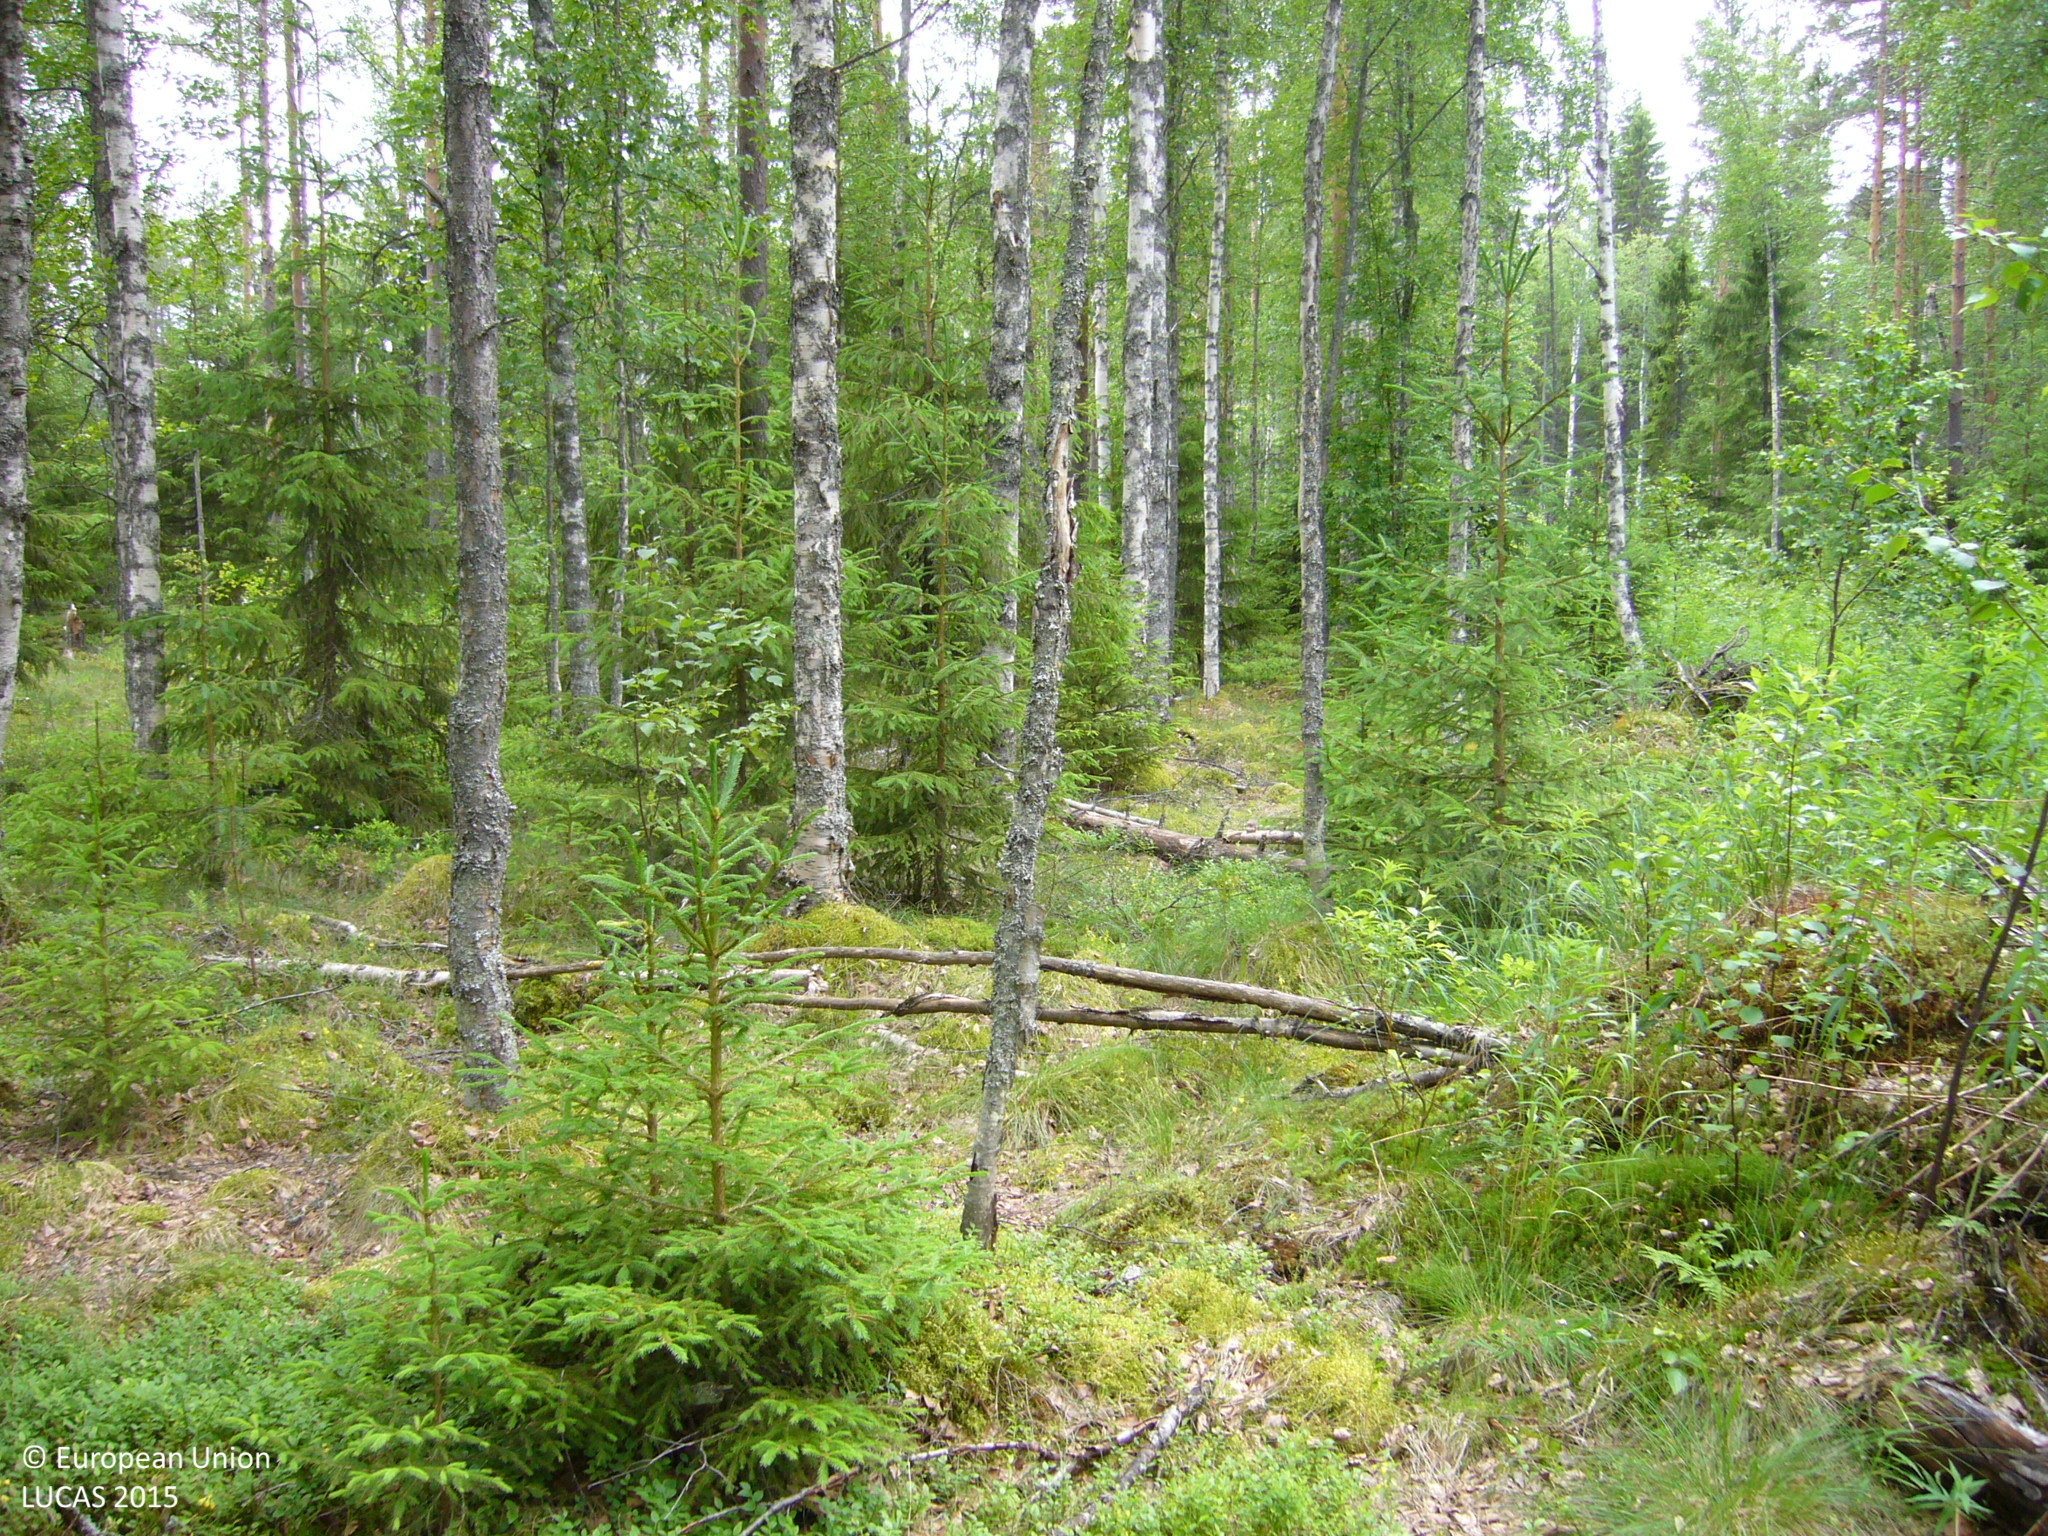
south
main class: Woodland
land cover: Pine dominated mixed woodland
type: boreal forest
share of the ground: 50 - 75 %
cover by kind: broadleaved forest trees 40 %, shrubs 35 %, coniferous forest trees 25 %
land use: Forestry
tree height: > 5 m
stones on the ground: 10 - 25 %
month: July
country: FI
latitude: 63.2345
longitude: 26.1015
